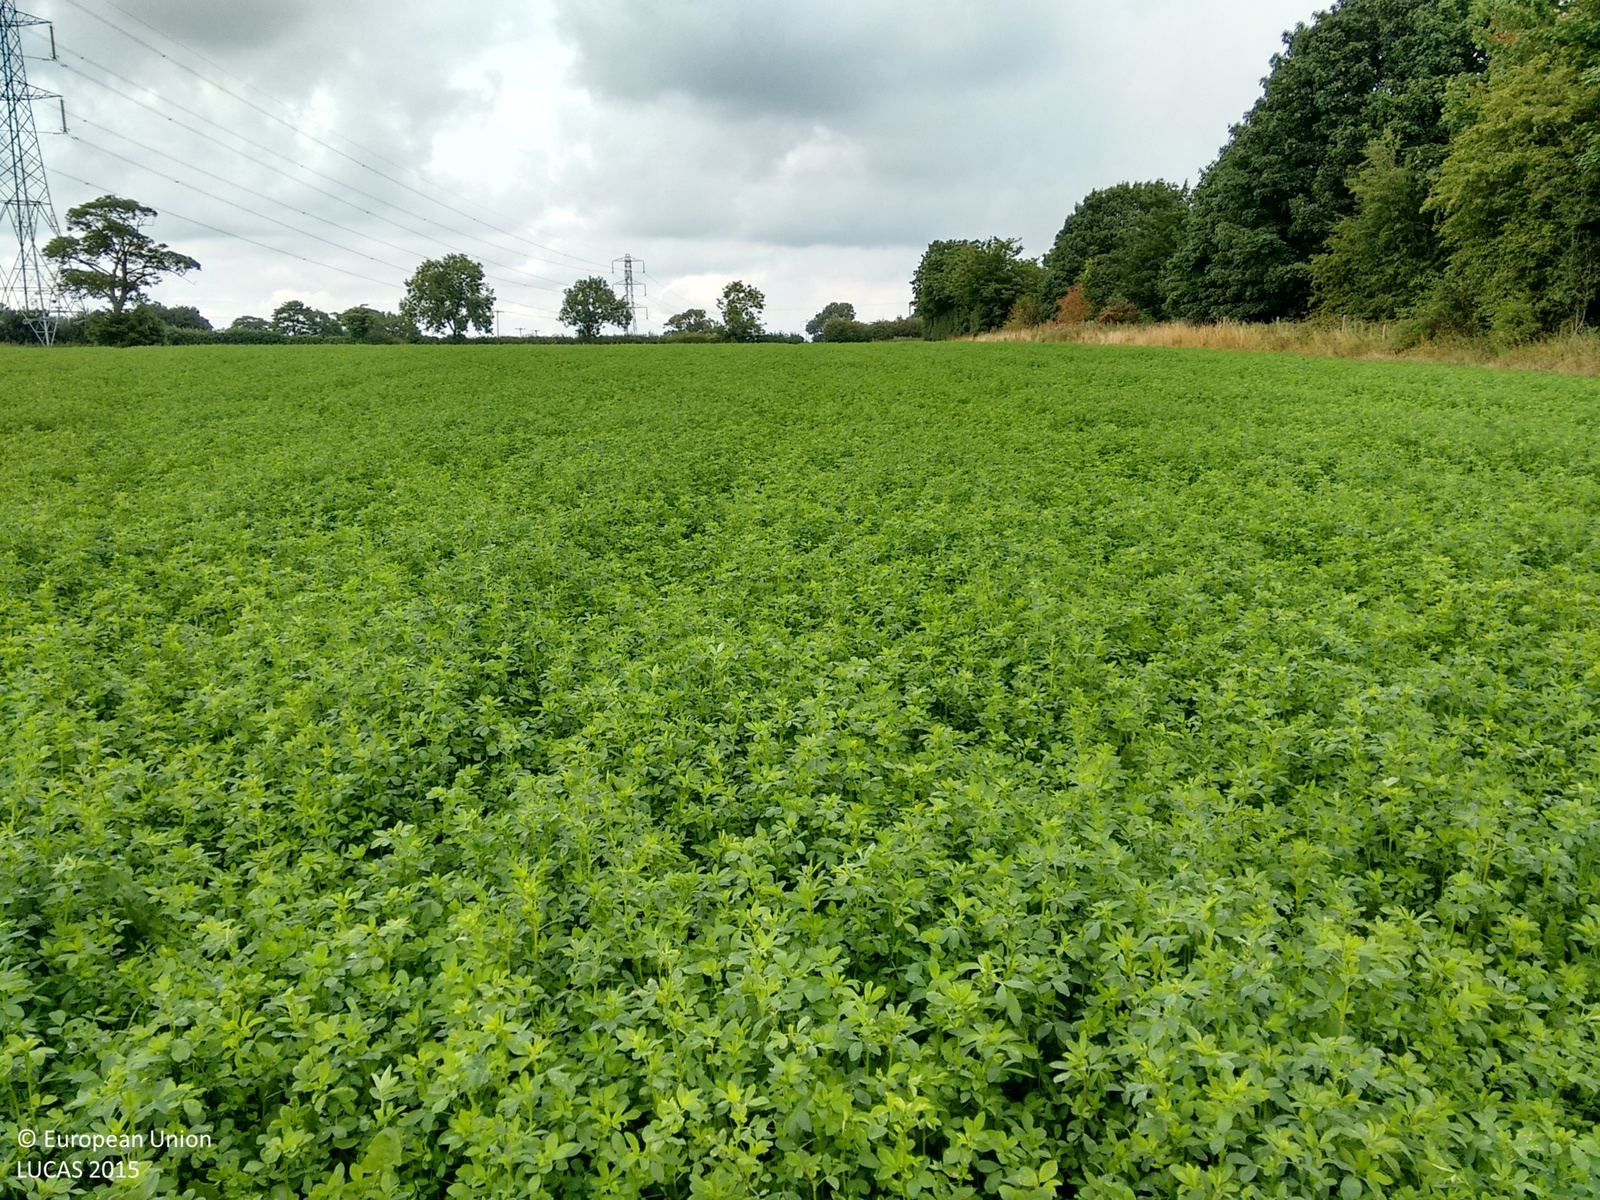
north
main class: Cropland
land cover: Lucerne
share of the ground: > 75 %
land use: Agriculture (excluding fallow land and kitchen gardens)
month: September
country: GB
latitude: 52.4817
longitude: -1.1933
